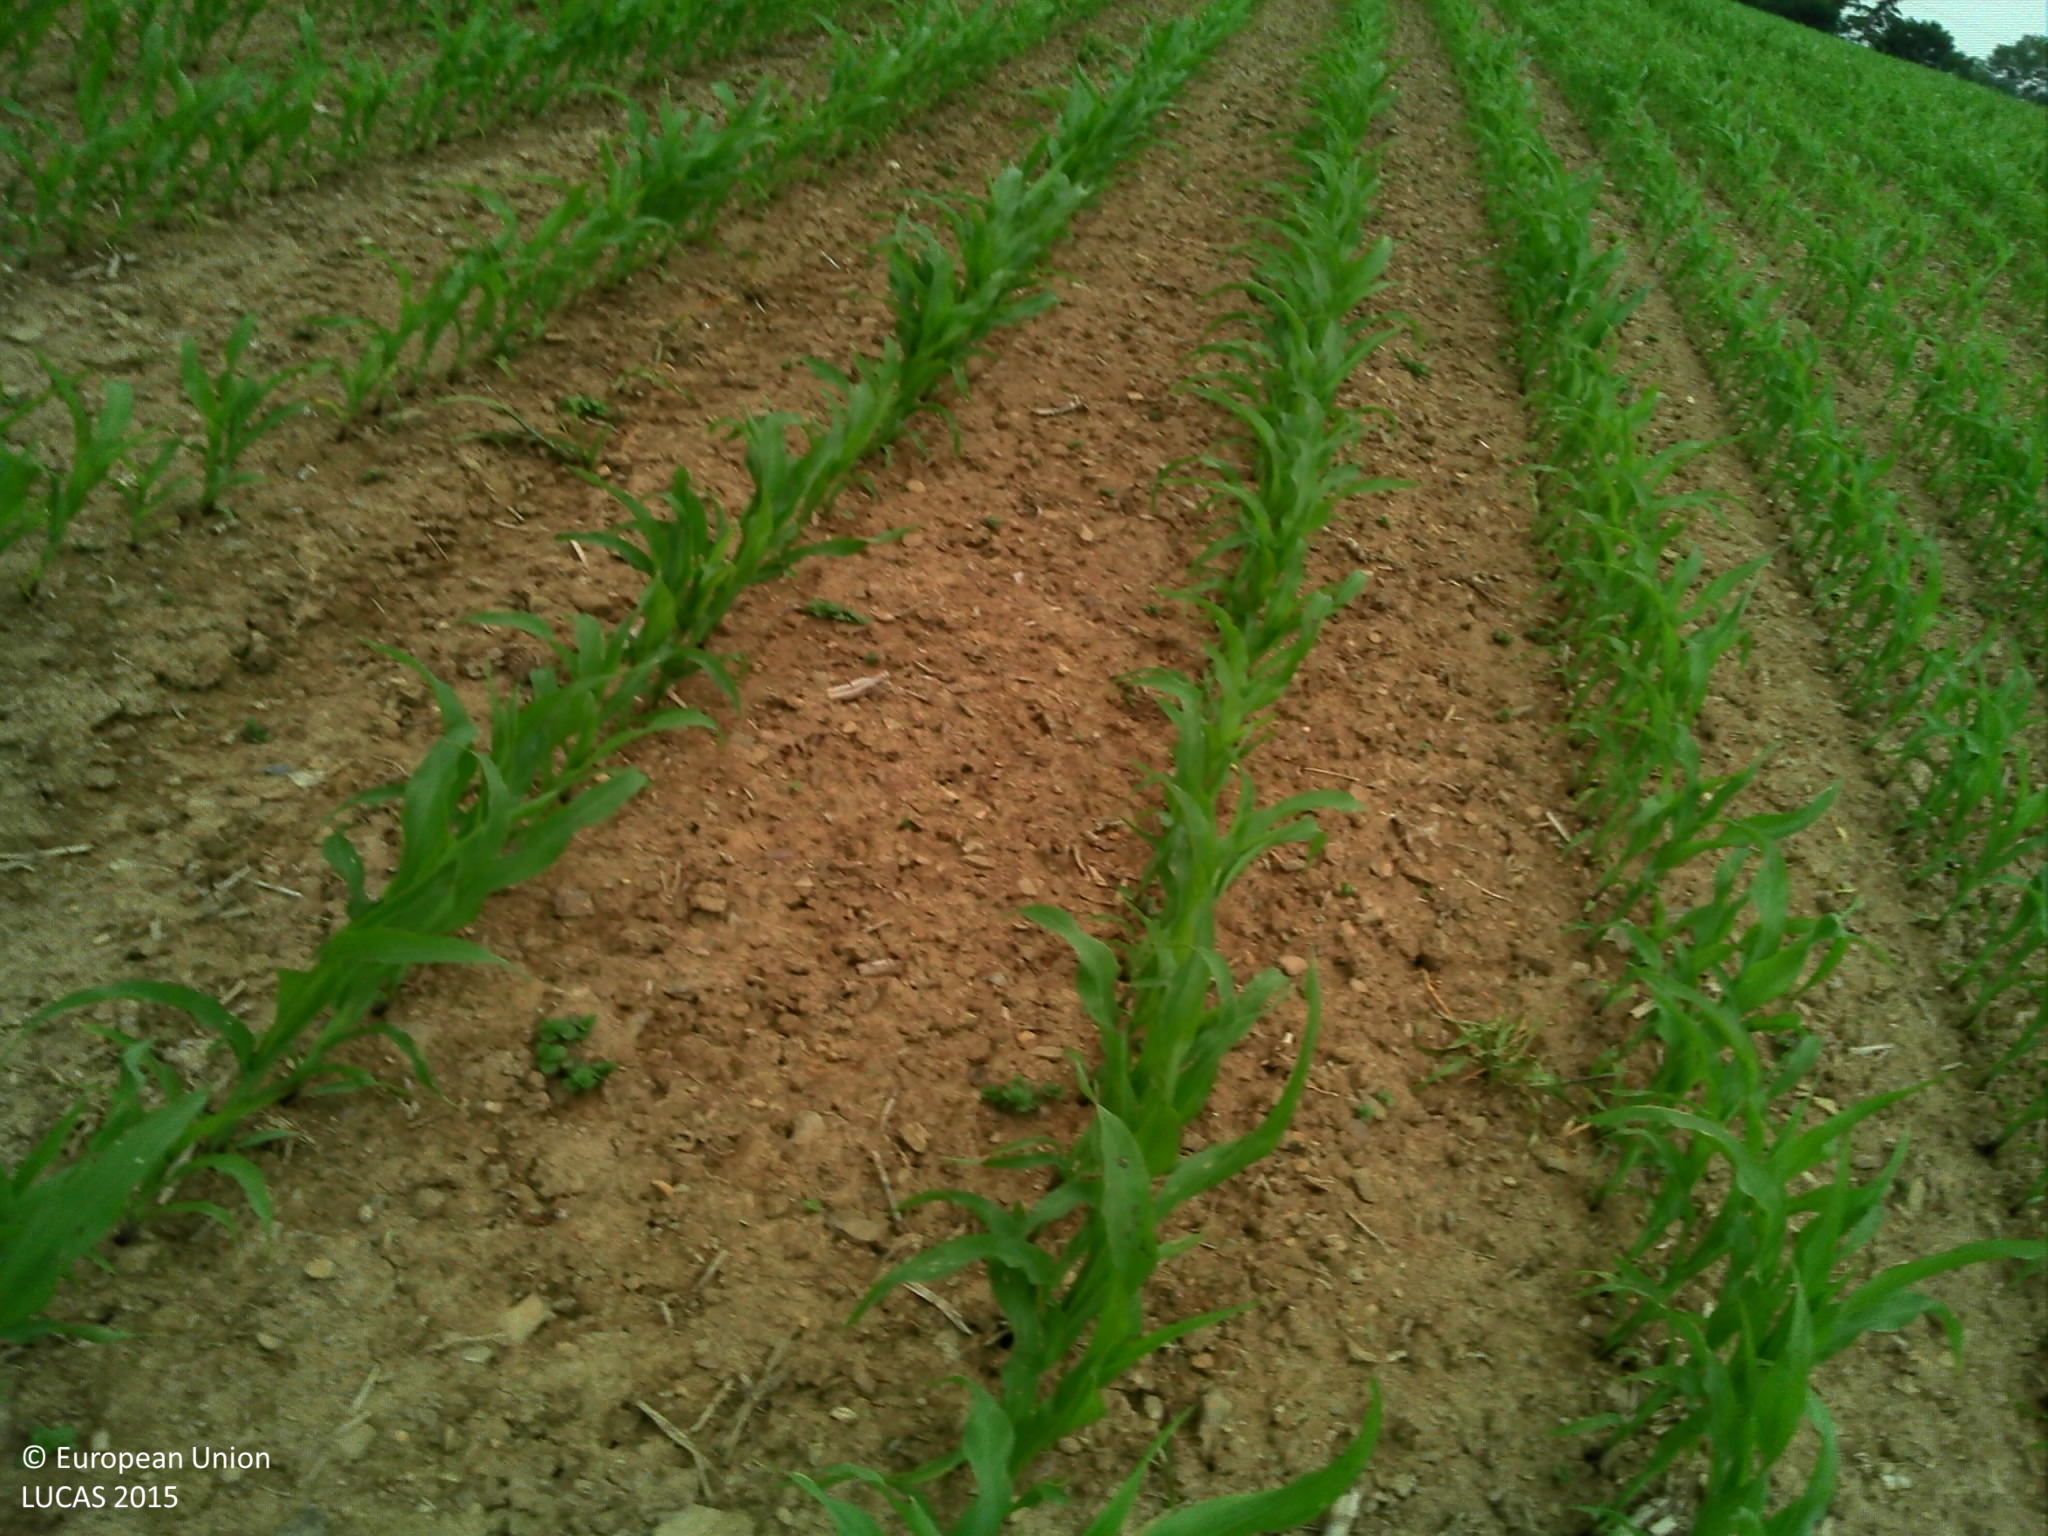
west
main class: Cropland
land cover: Maize
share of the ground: > 75 %
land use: Agriculture (excluding fallow land and kitchen gardens)
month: June
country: FR
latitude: 48.1207
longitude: -2.0770
